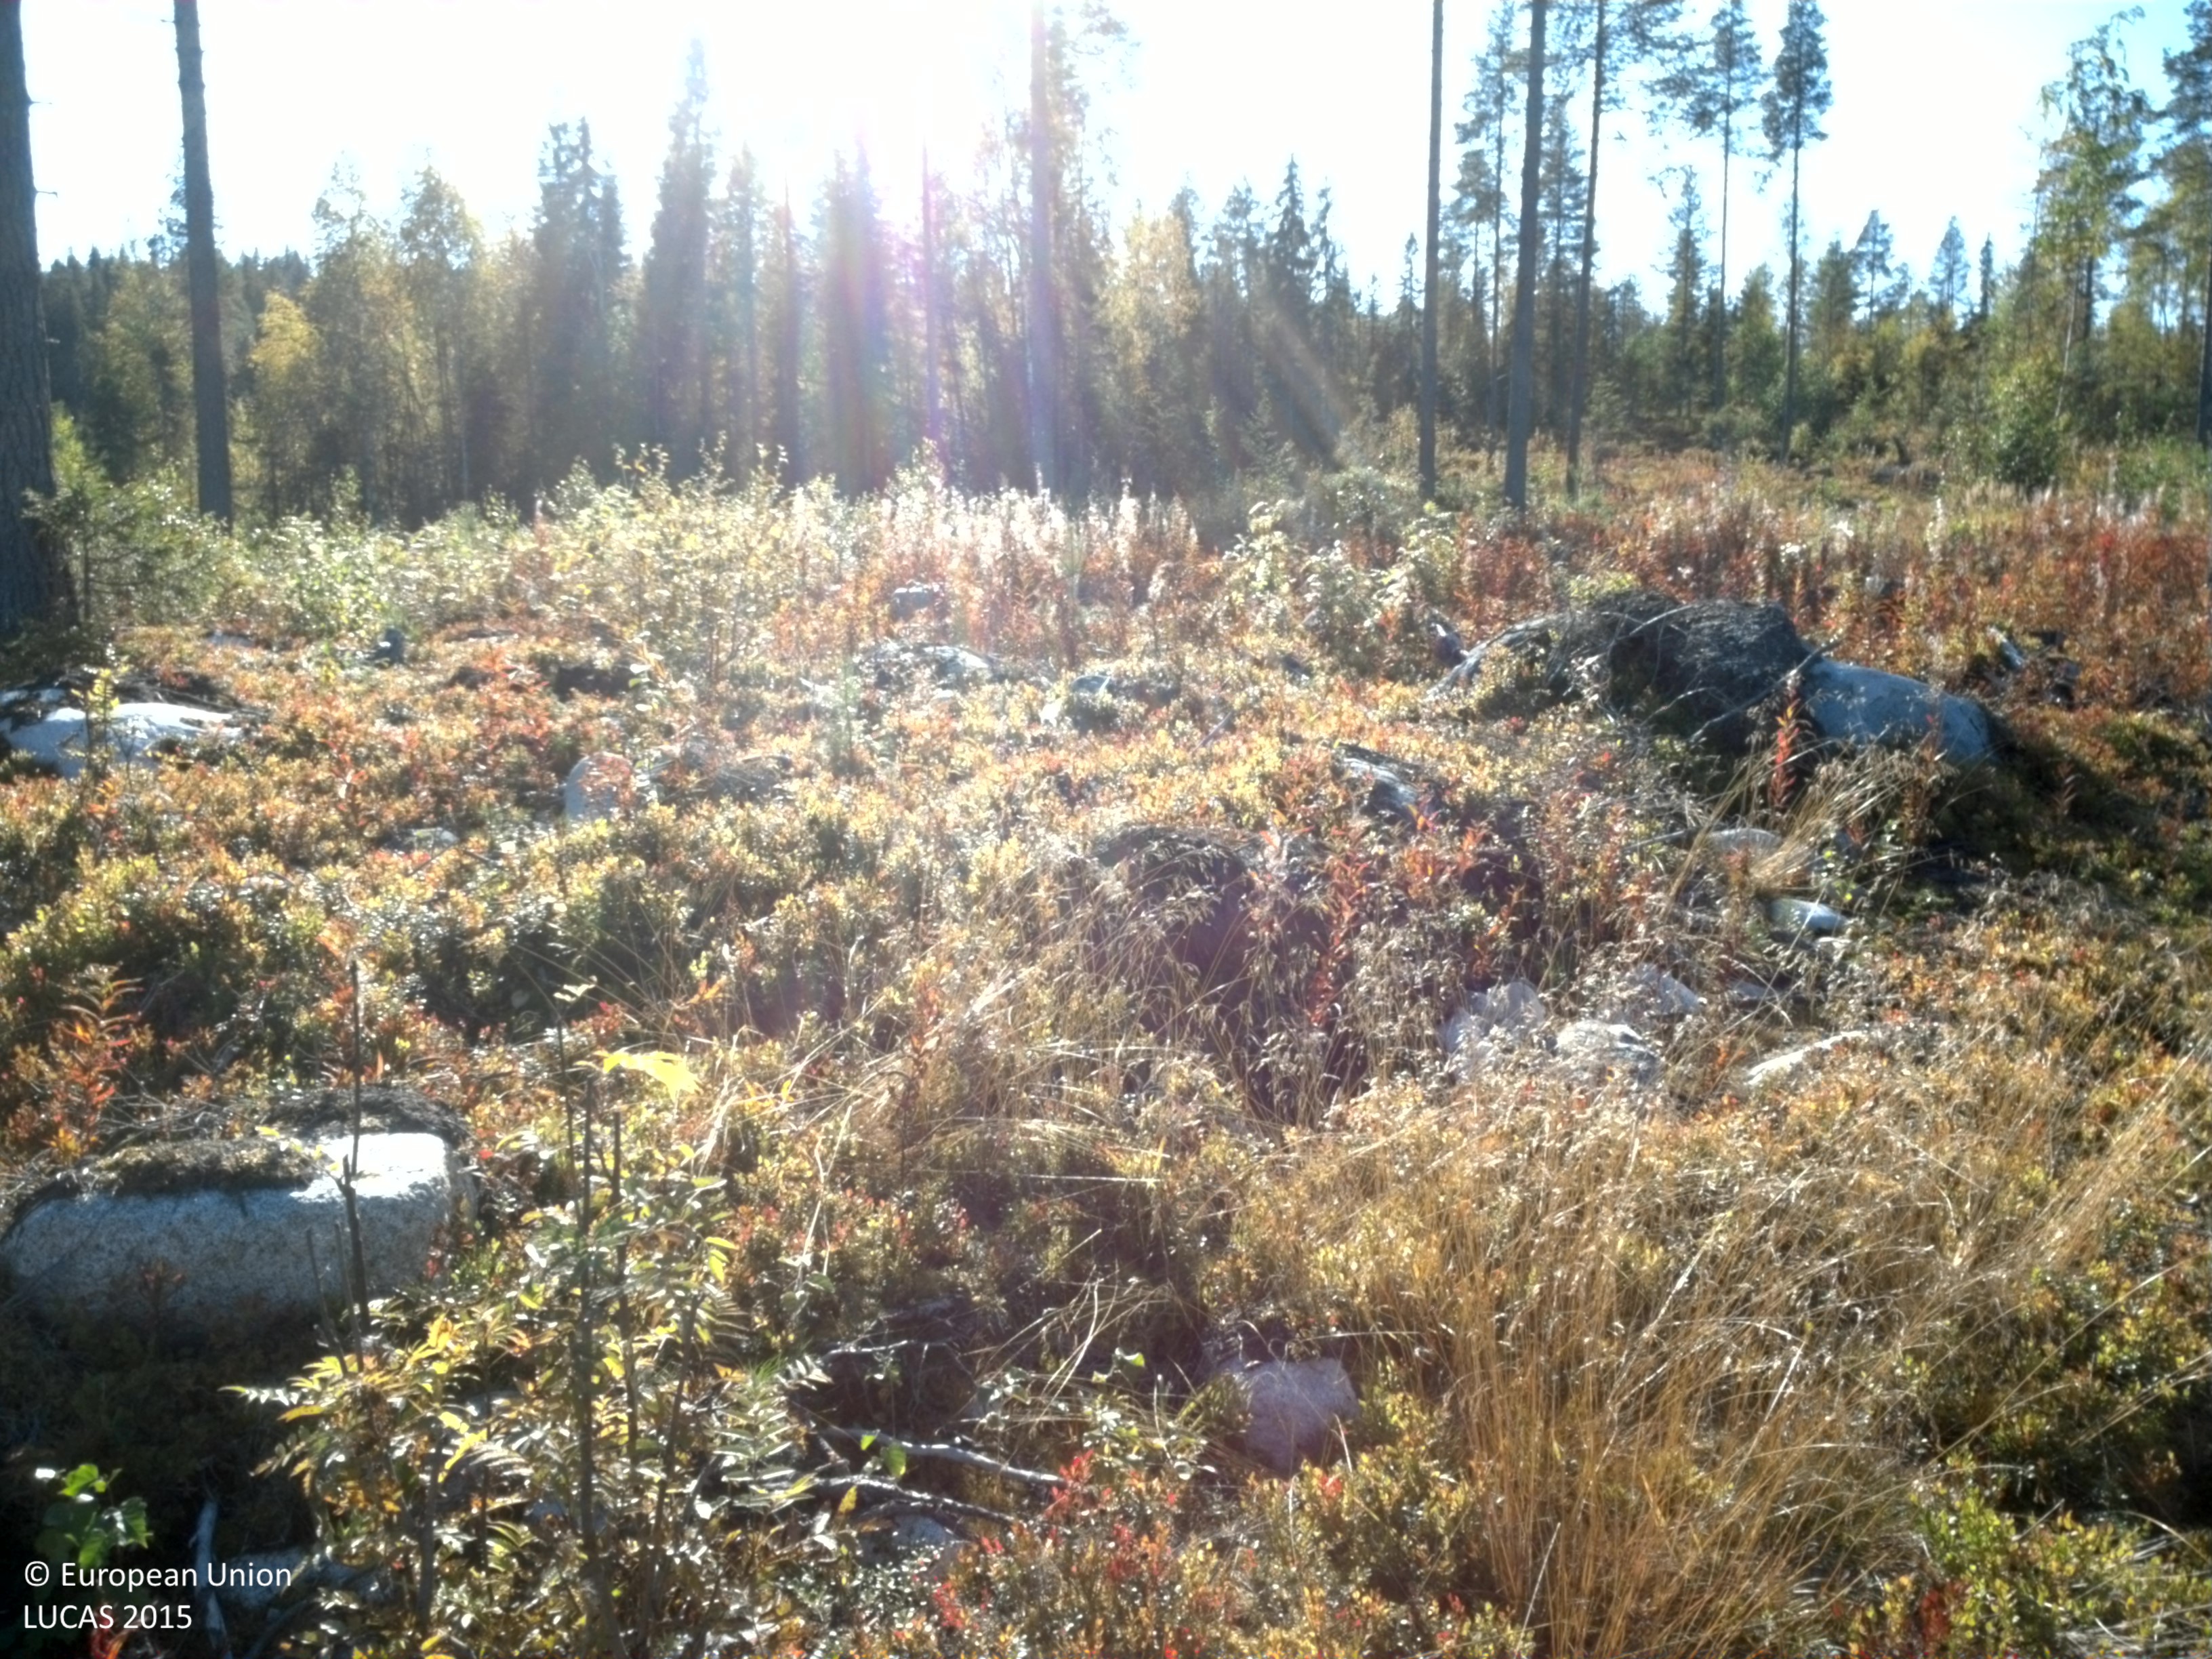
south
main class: Shrubland
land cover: Shrubland with sparse tree cover
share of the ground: > 75 %
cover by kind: shrubs 90 %, broadleaved forest trees 5 %, consolidated bare surface 5 %
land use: Forestry
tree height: < 5 m
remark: Clear cut
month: September
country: SE
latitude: 65.9118
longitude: 22.1178
